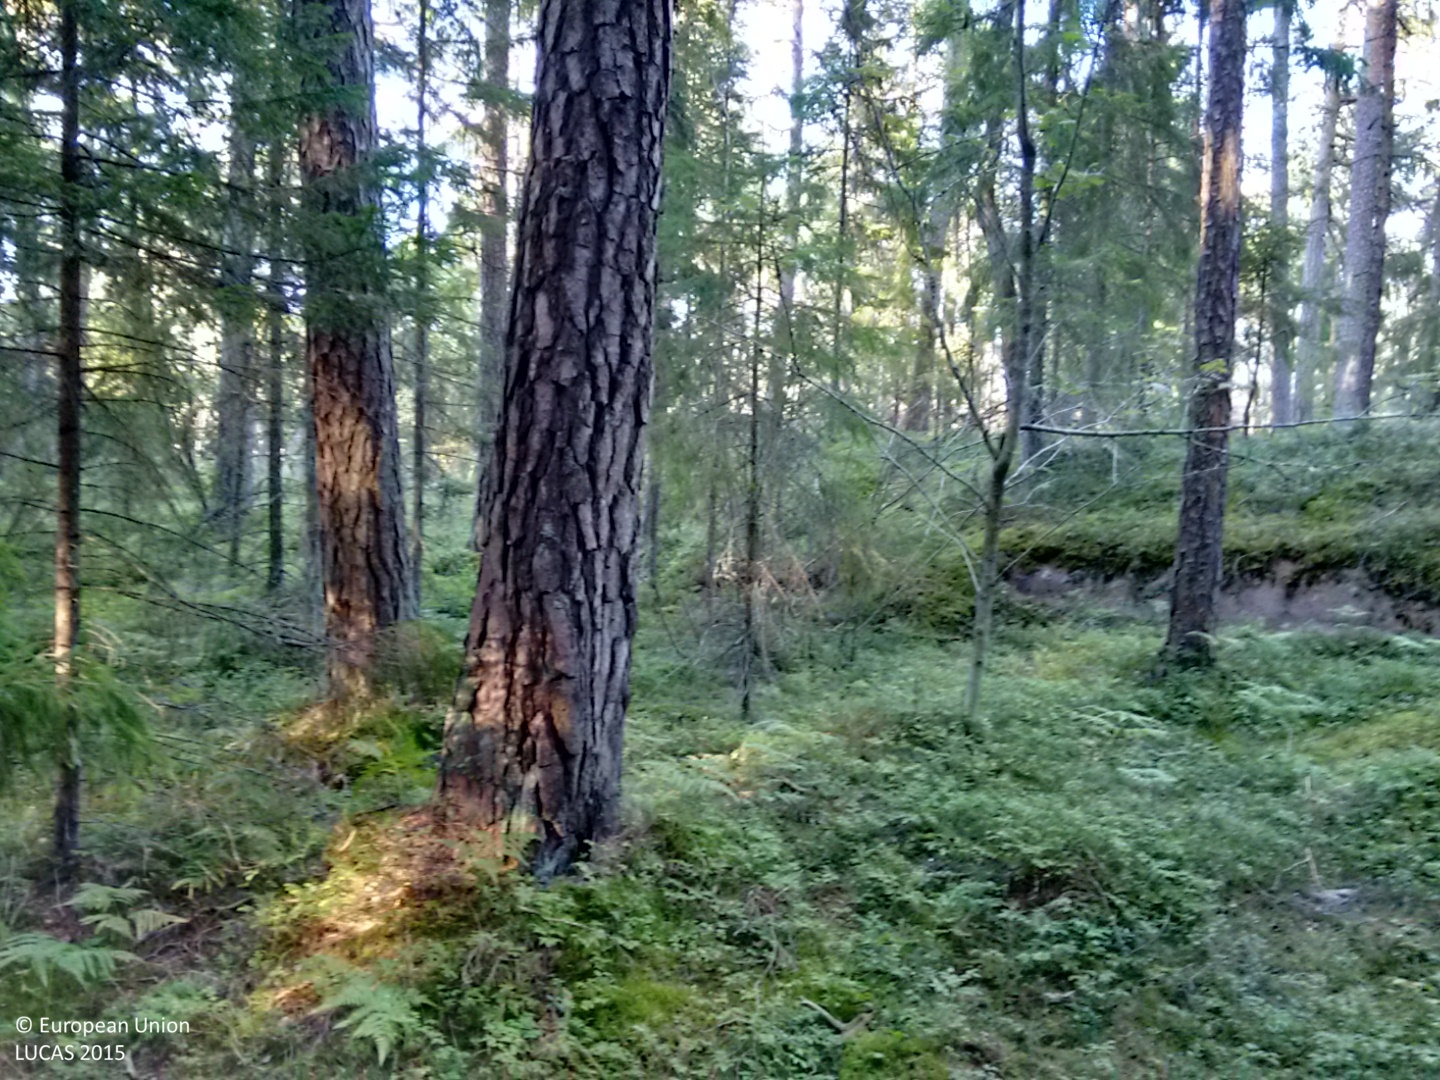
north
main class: Woodland
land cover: Pine dominated coniferous woodland
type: hemiboreal forest and nemoral coniferous forest and mixed broadleaved-coniferous forest
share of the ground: > 75 %
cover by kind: coniferous forest trees 85 %, shrubs 5 %, herbaceous plants 5 %, lichens and mosses 5 %
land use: Forestry
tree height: > 5 m
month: August
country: FI
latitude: 60.2631
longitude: 19.9648
